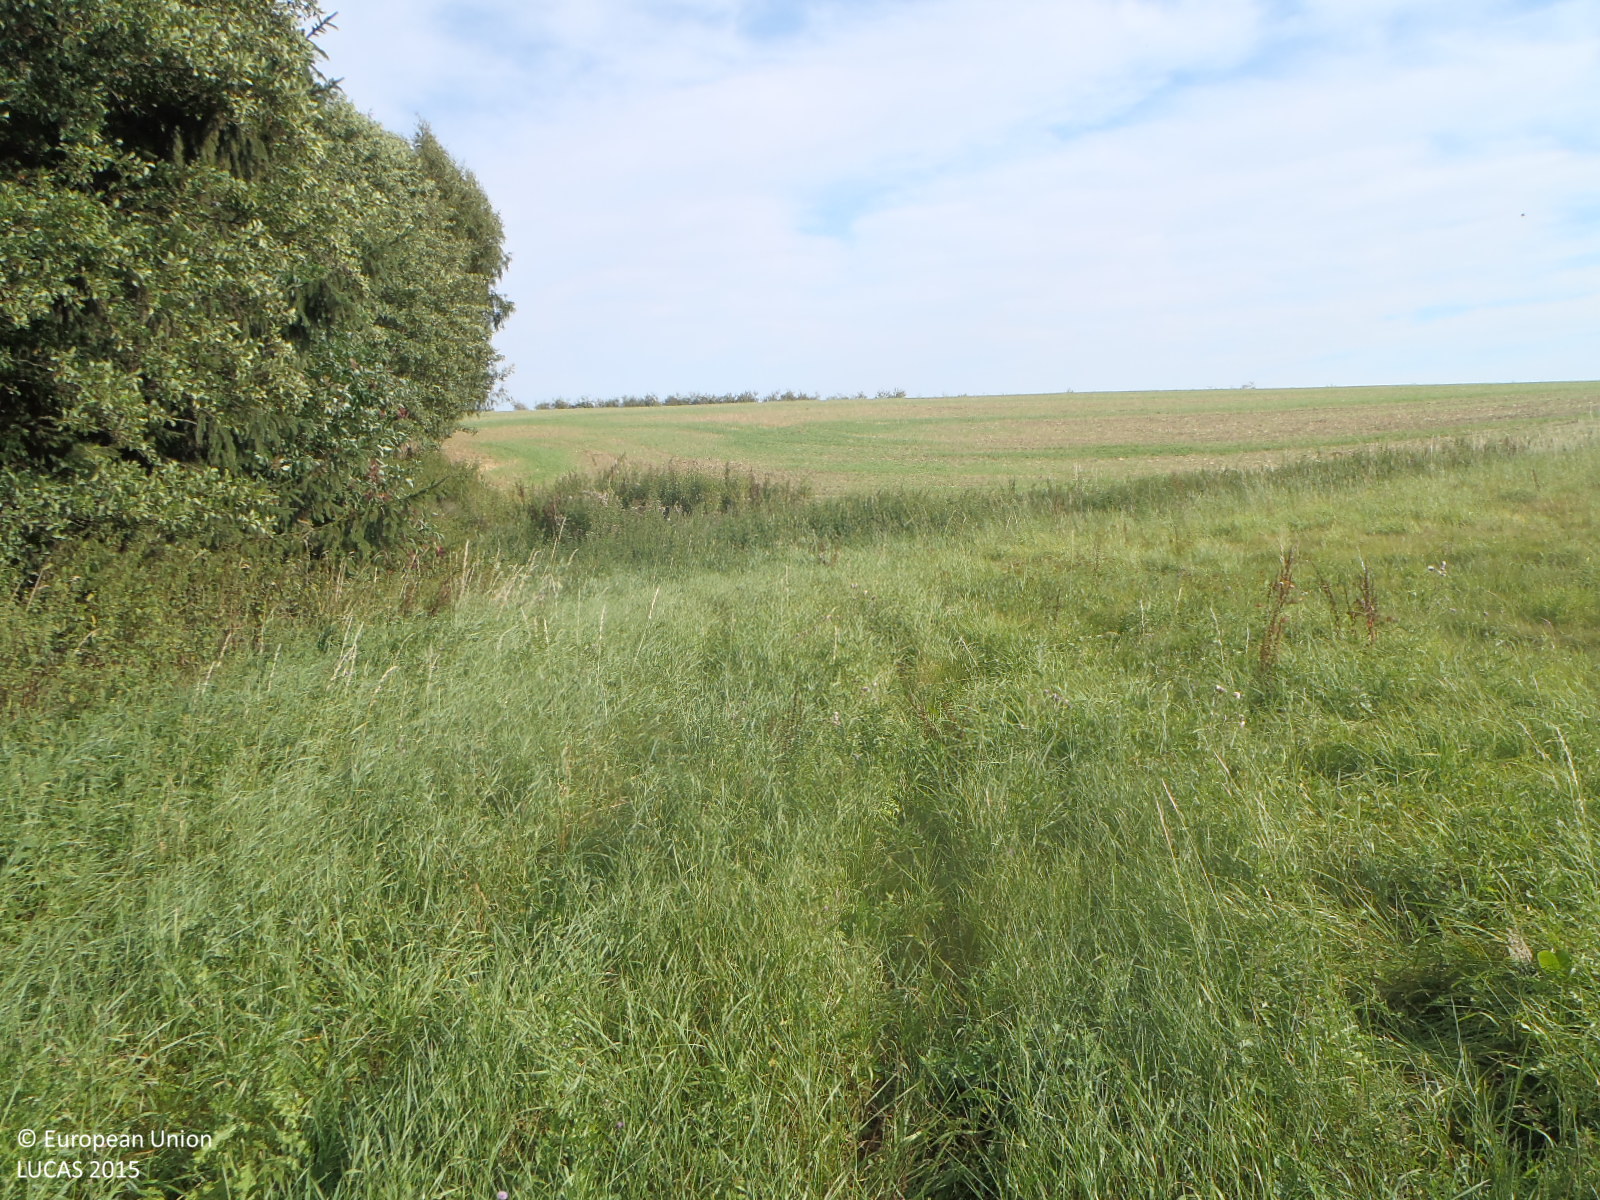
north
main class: Grassland
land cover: Grassland without tree/shrub cover
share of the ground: > 75 %
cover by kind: herbaceous plants 100 %
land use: Agriculture (excluding fallow land and kitchen gardens)
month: August
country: CZ
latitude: 50.9932
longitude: 15.0038
